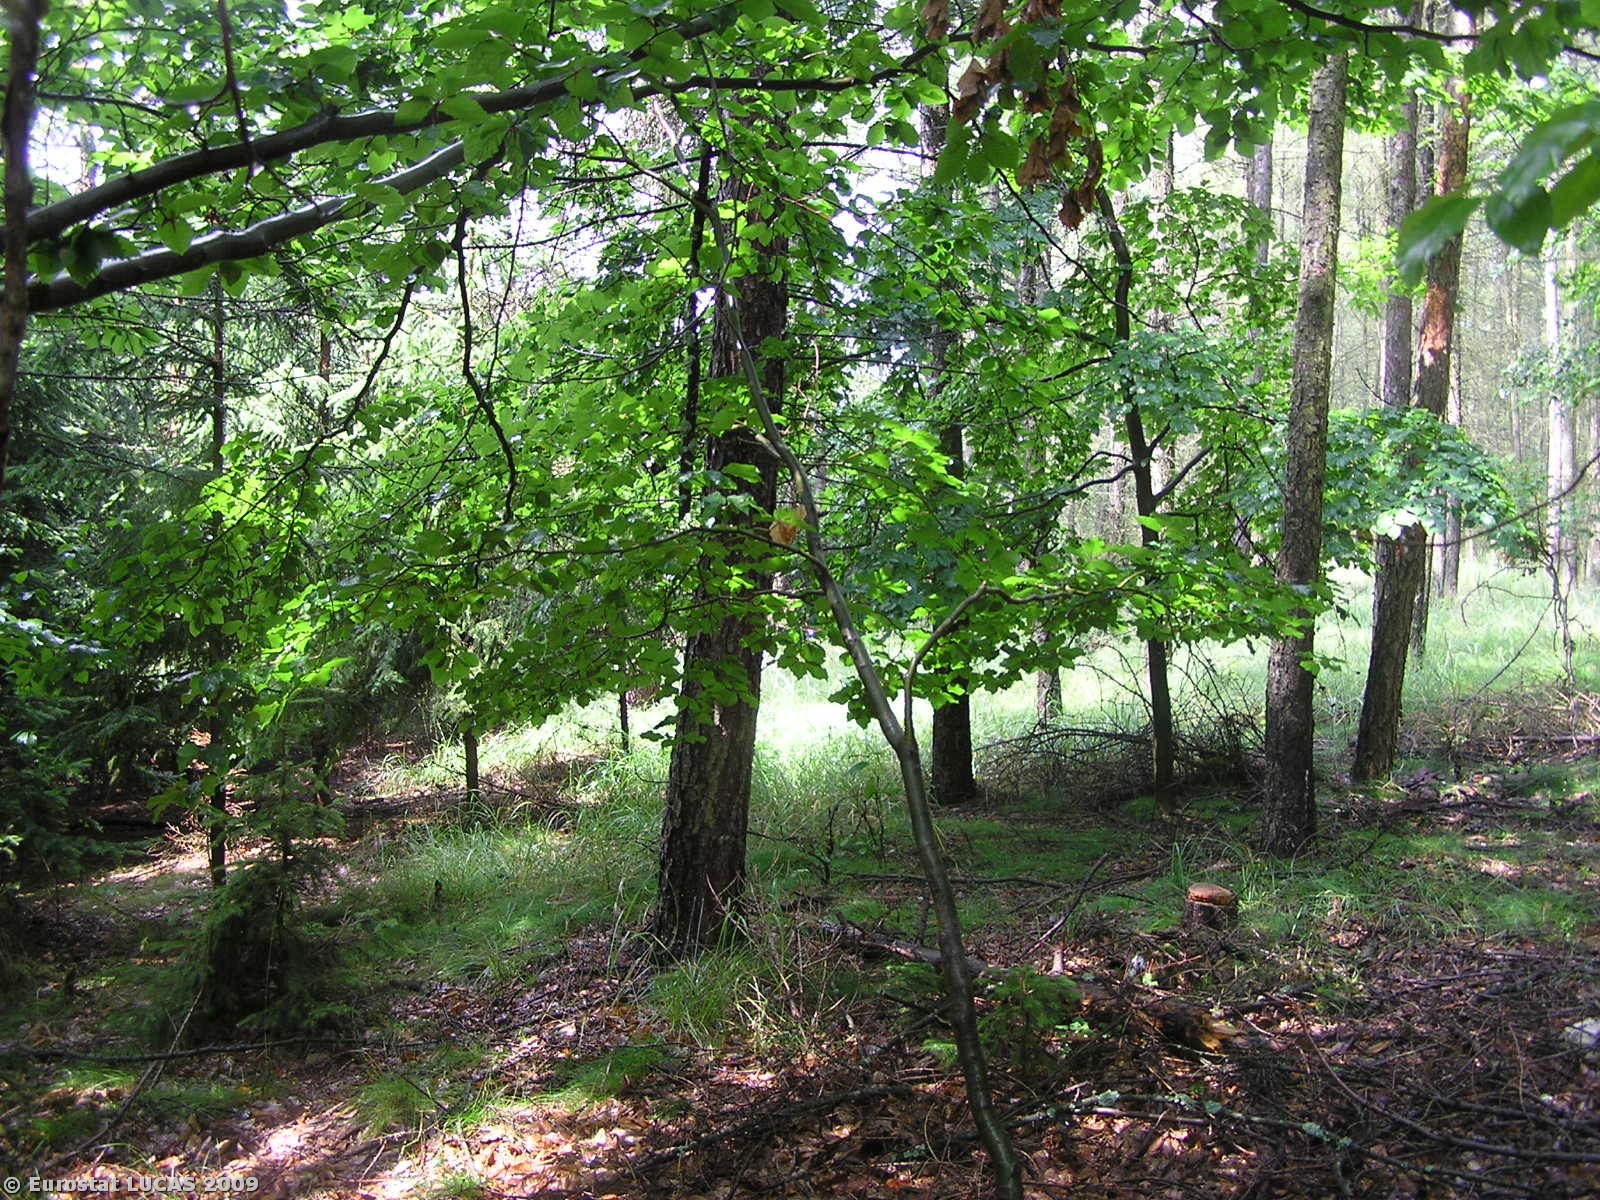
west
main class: Woodland
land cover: Broadleaved woodland
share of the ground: > 75 %
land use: Forestry
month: June
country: CZ
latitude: 49.6780
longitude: 15.0055
